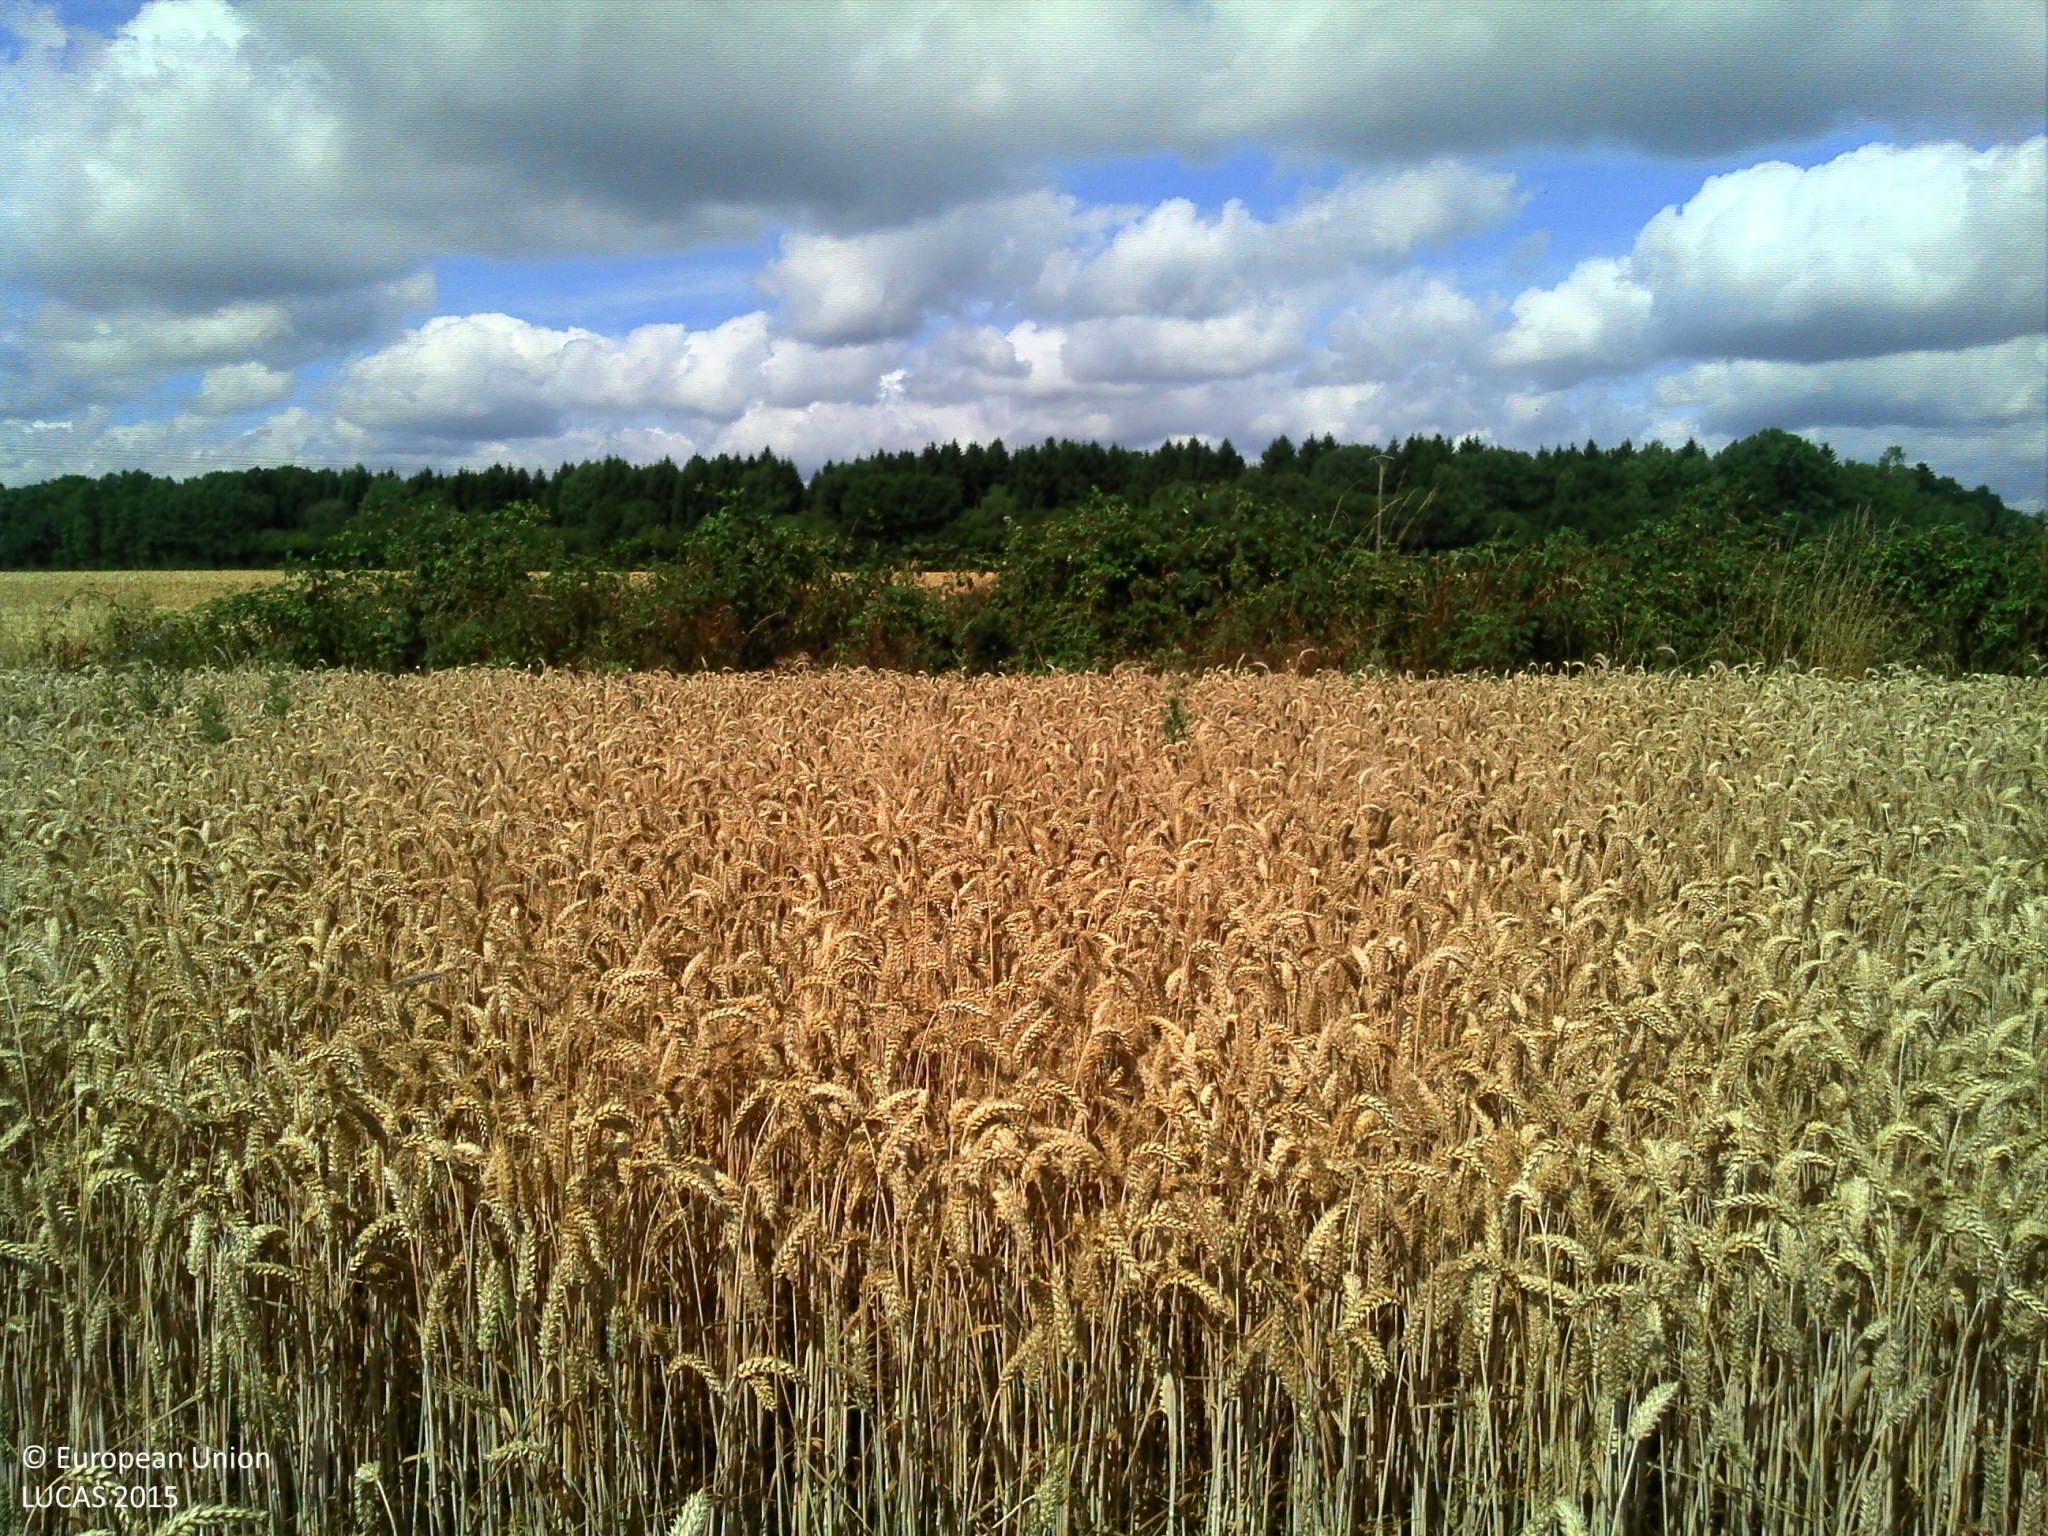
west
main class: Cropland
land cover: Common wheat
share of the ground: > 75 %
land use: Agriculture (excluding fallow land and kitchen gardens)
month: July
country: FR
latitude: 48.8120
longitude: 0.5378
